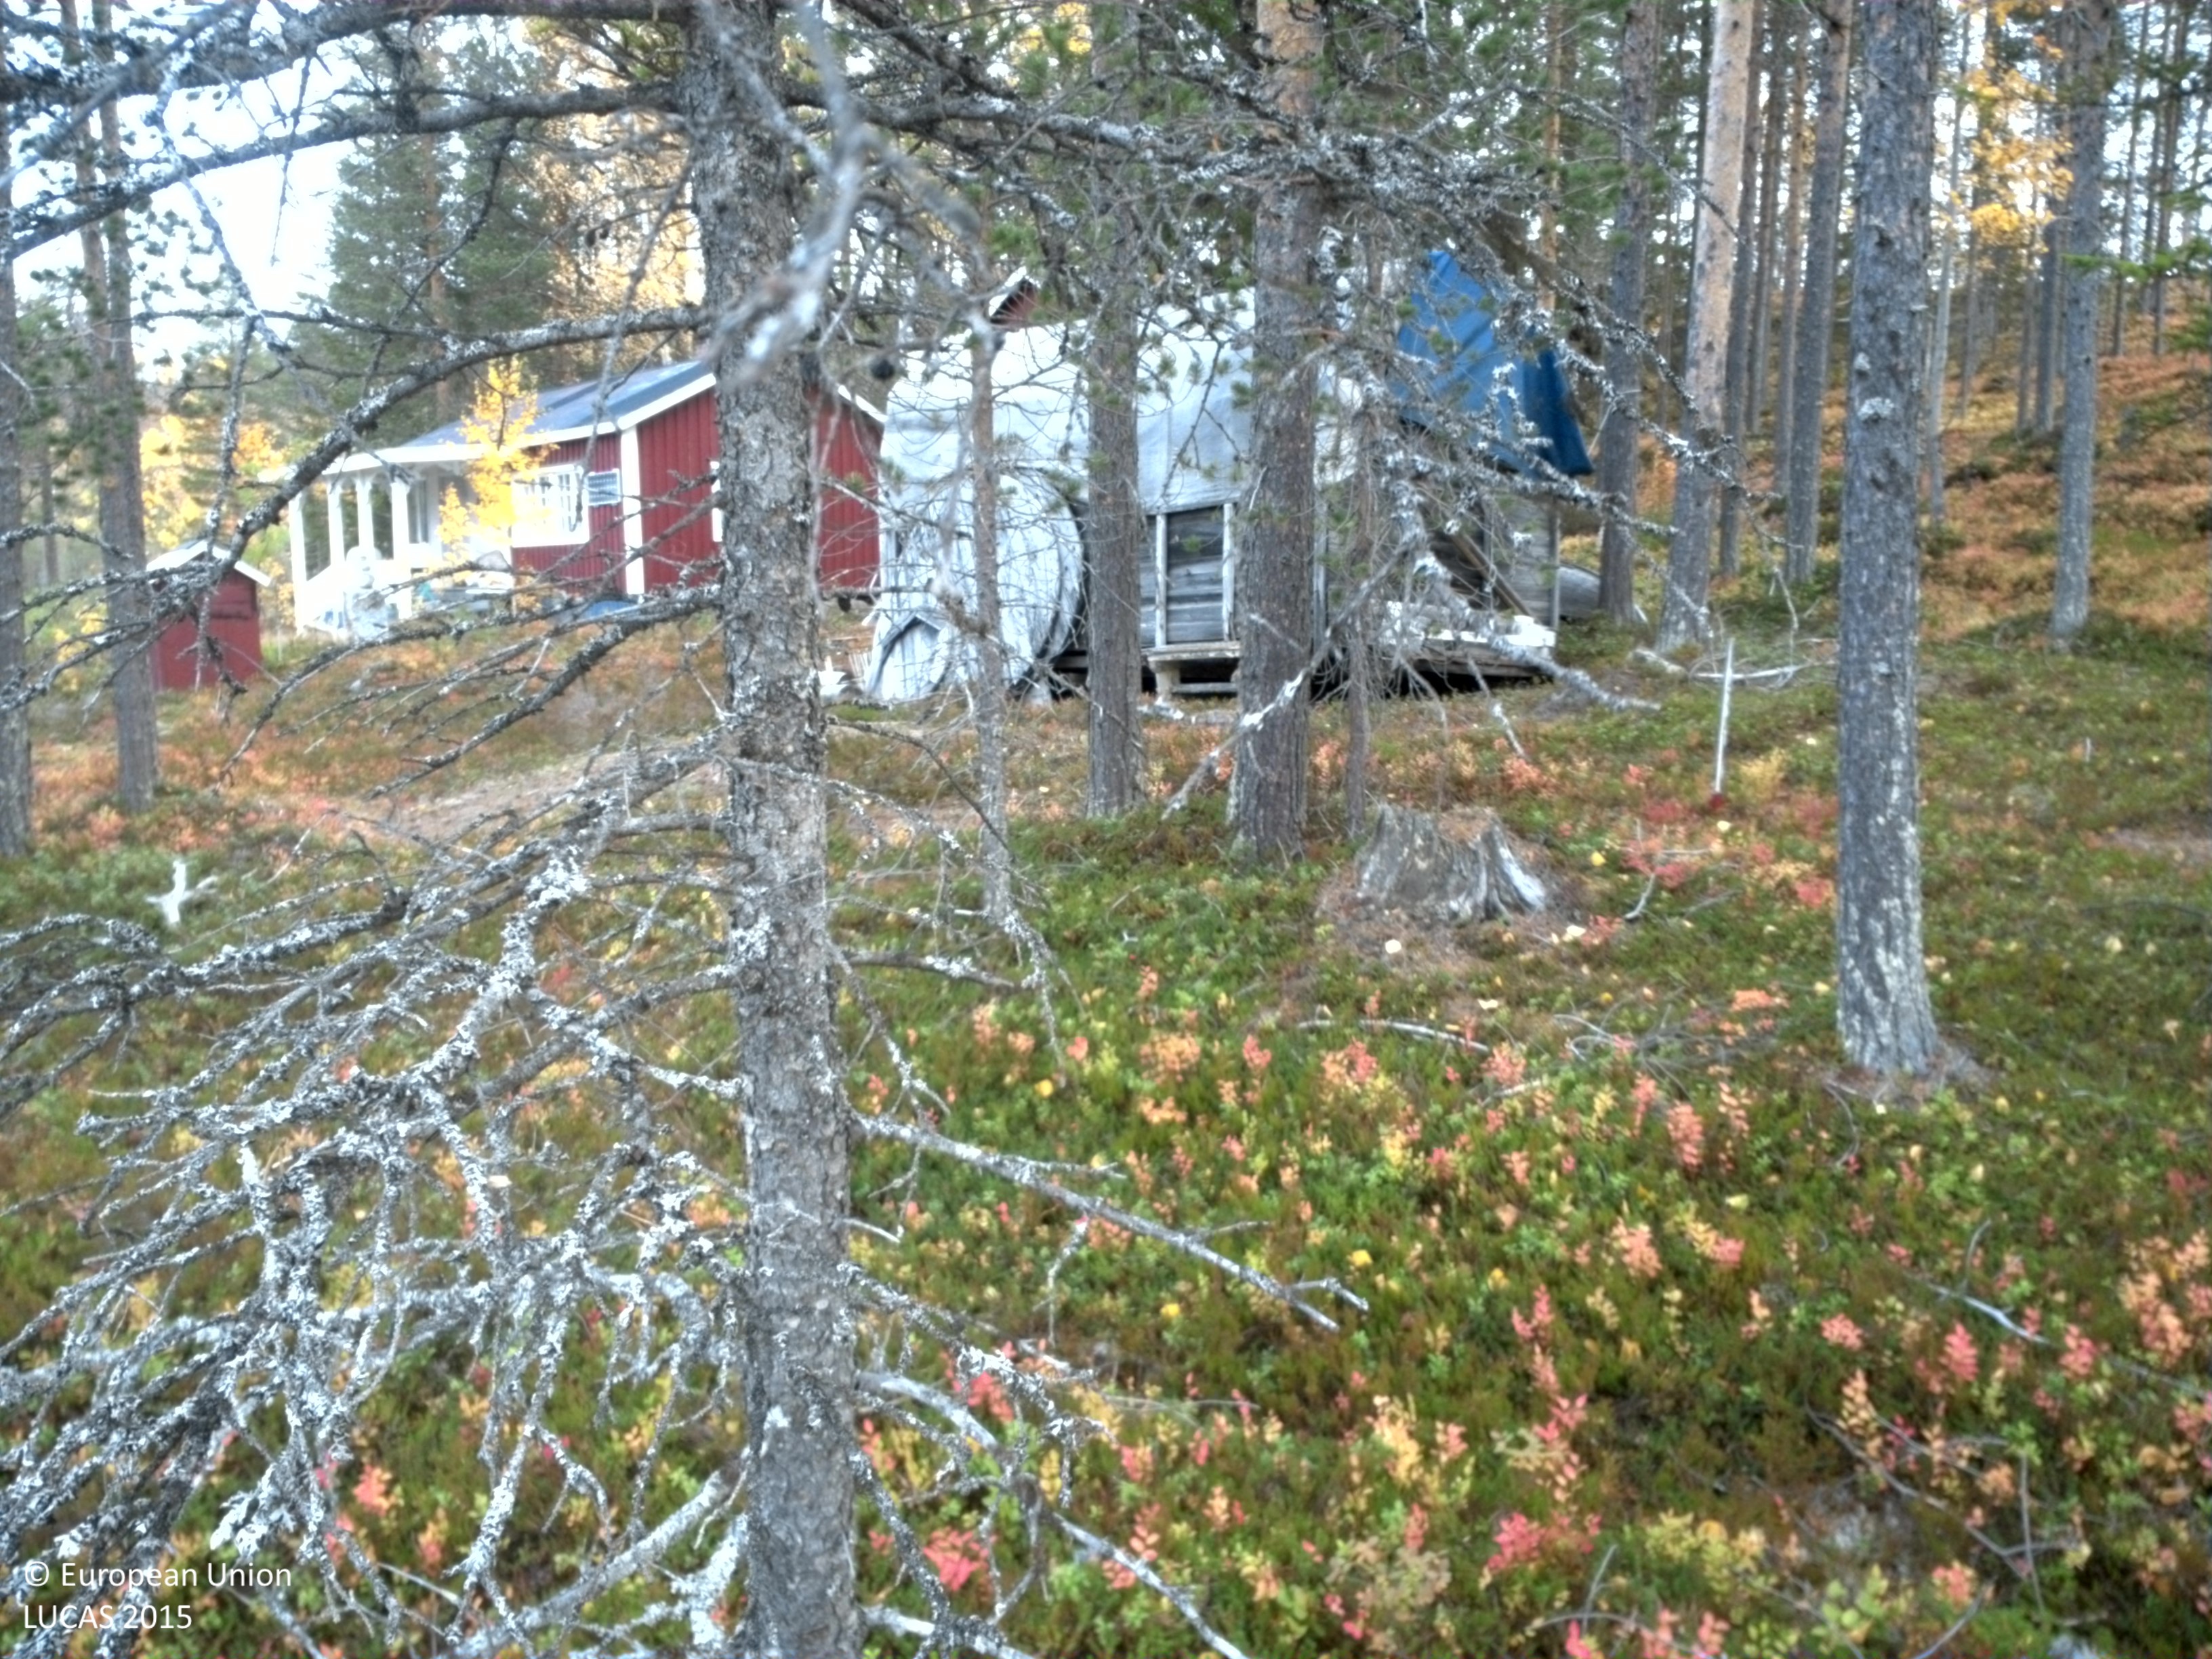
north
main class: Woodland
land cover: Pine dominated coniferous woodland
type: boreal forest
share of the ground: 25 - 50 %
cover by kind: shrubs 45 %, coniferous forest trees 40 %, lichens and mosses 10 %, broadleaved forest trees 5 %
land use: Forestry
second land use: Residential
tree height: > 5 m
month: October
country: SE
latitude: 65.0576
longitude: 17.4653
